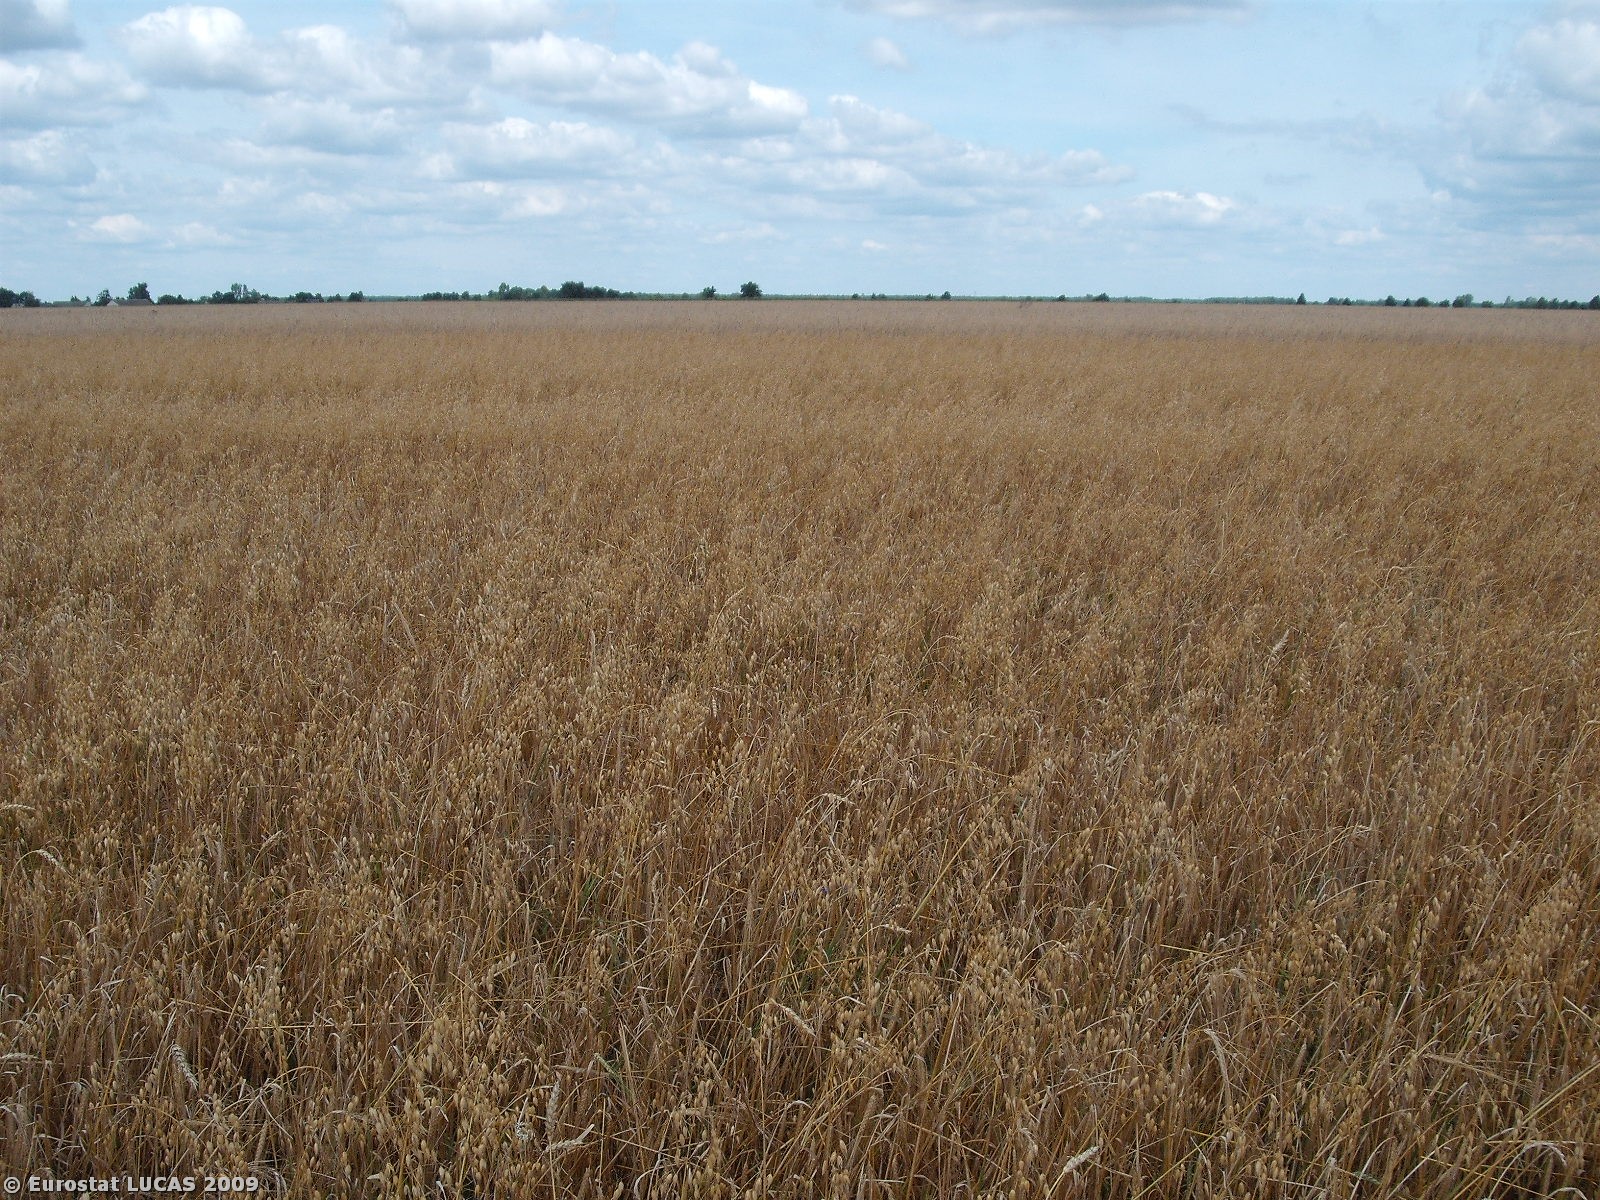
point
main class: Cropland
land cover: Barley
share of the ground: 50 - 75 %
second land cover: Oats
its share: 25 - 50 %
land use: Agriculture (excluding fallow land and kitchen gardens)
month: July
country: PL
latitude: 51.3178
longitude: 21.3992
